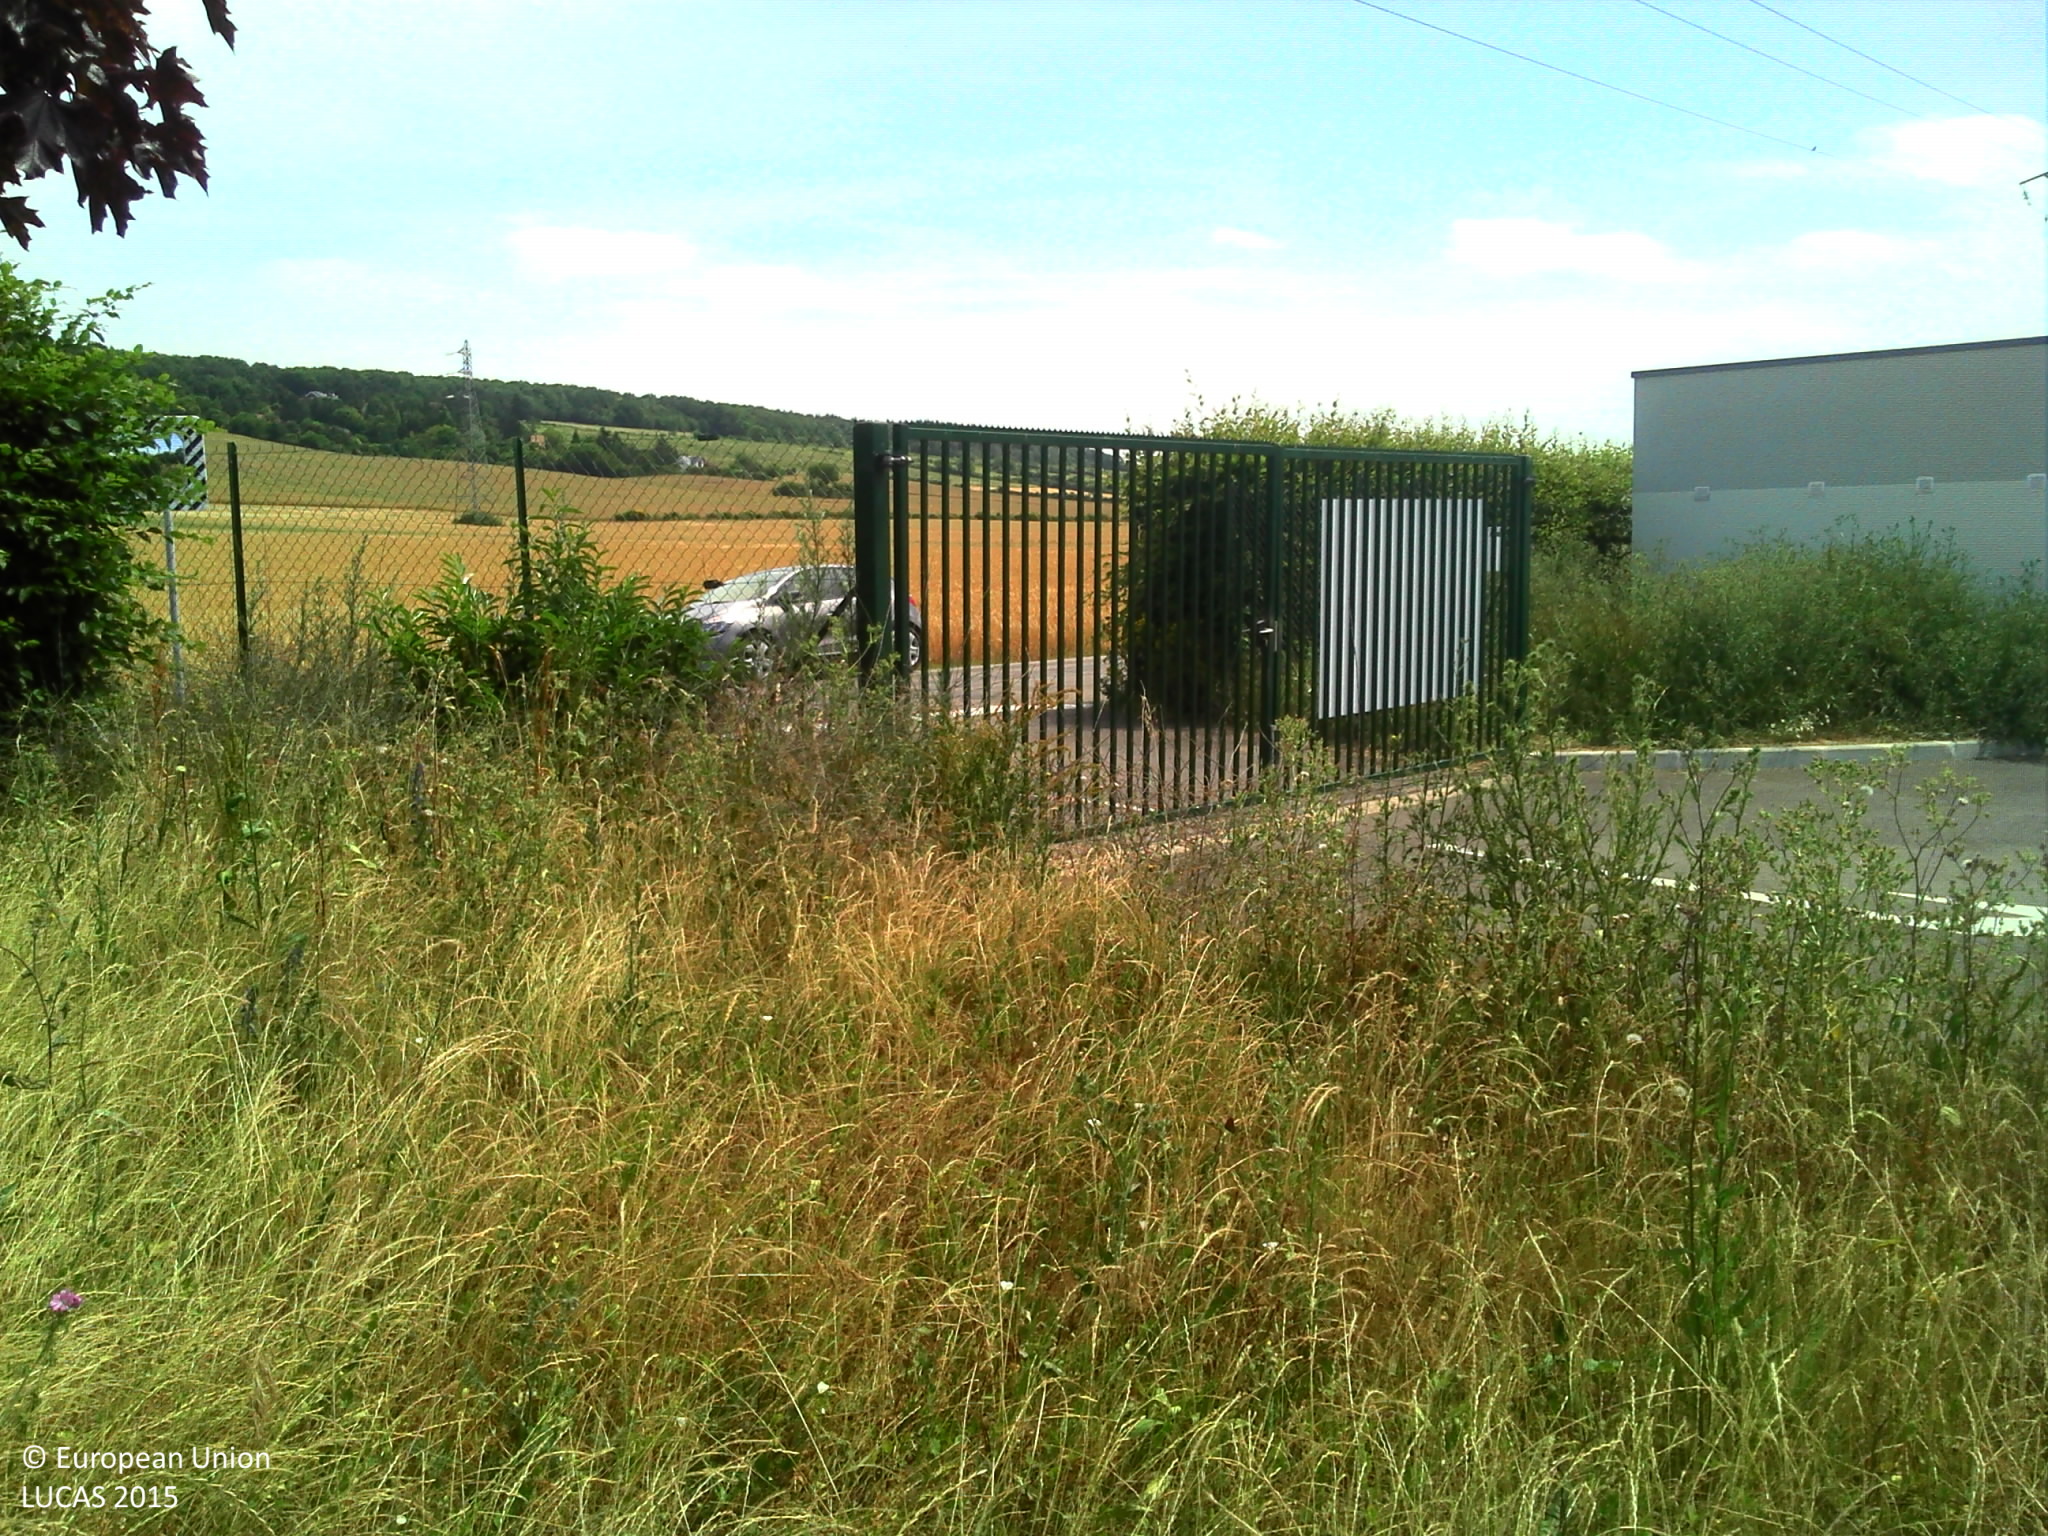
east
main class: Grassland
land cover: Spontaneously vegetated surfaces
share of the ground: > 75 %
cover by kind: herbaceous plants 95 %, shrubs 5 %
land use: Waste treatment
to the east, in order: Spontaneously vegetated surfaces; Fences; Grassland without tree/shrub cover; Managed hedges; Electric lines; Paved roads, cycling and walking lanes; Grass margins; Barley; Common wheat; Barley
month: June
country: FR
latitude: 49.1060
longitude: 1.2546
